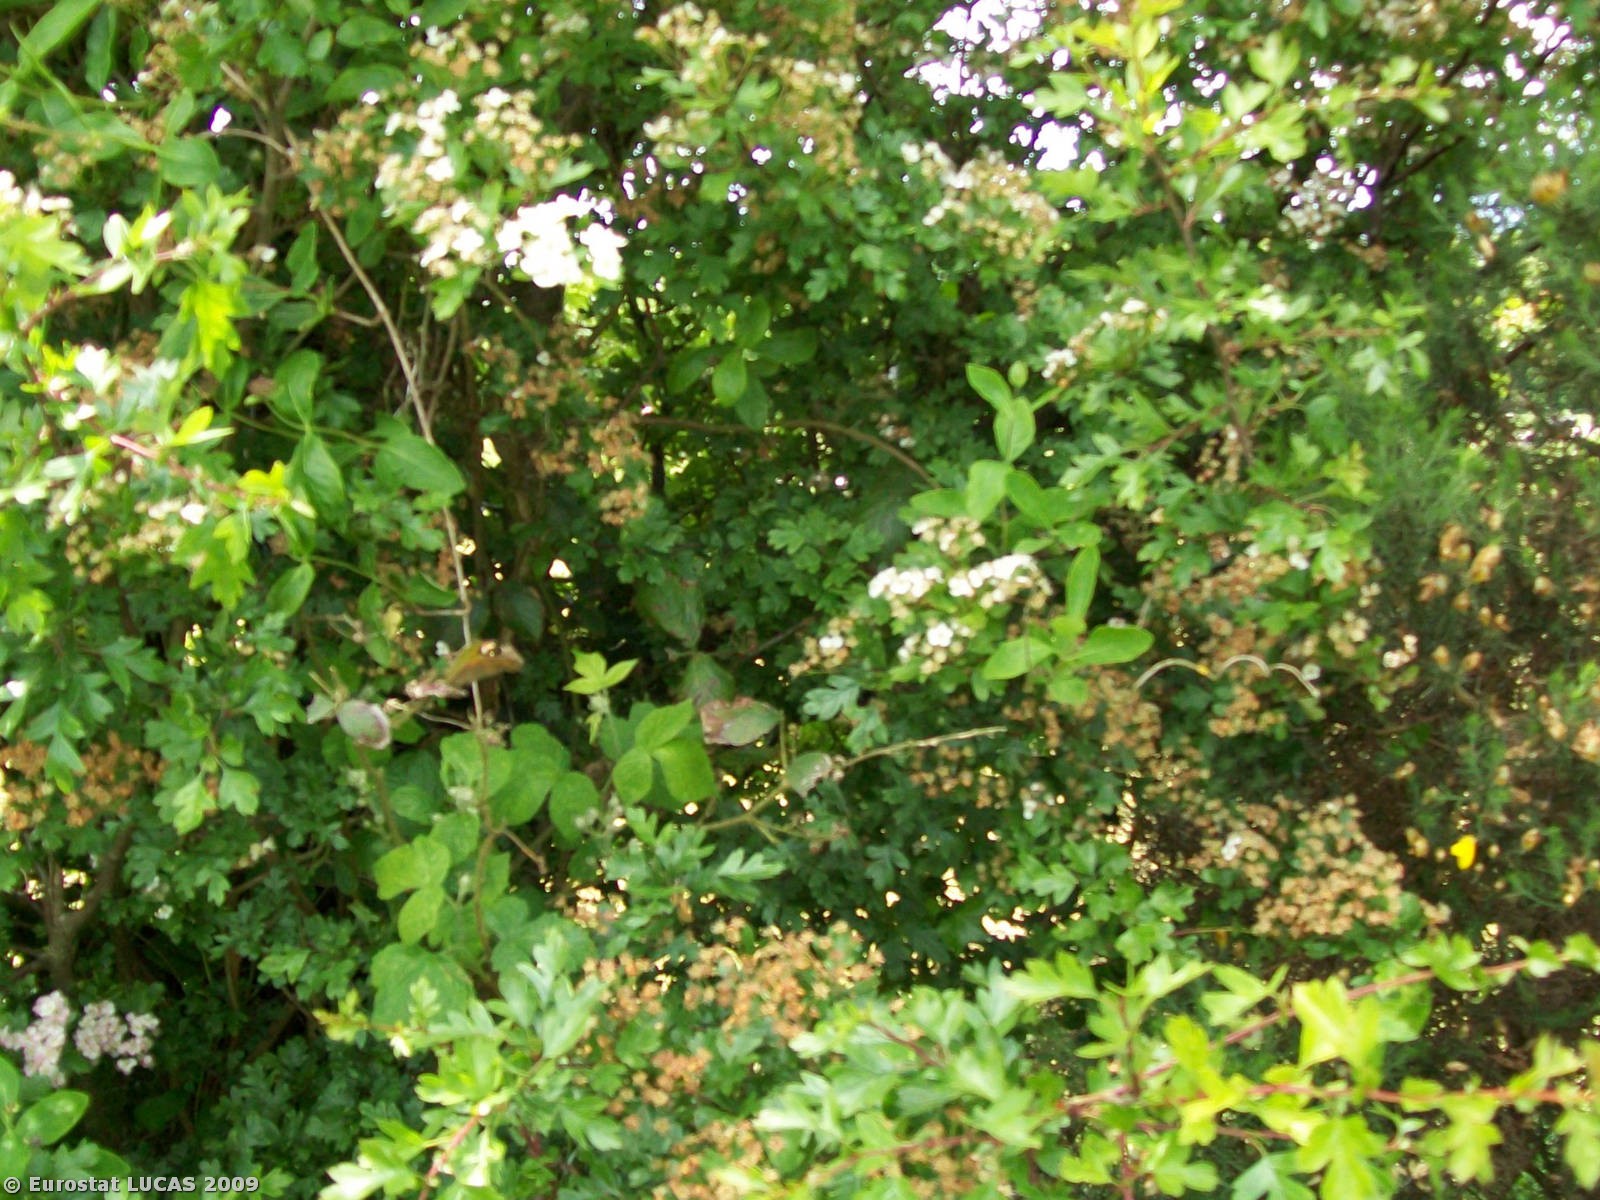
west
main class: Grassland
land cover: Grassland without tree/shrub cover
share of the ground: > 75 %
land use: Agriculture (excluding fallow land and kitchen gardens)
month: June
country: GB
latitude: 54.5568
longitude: -7.4251
